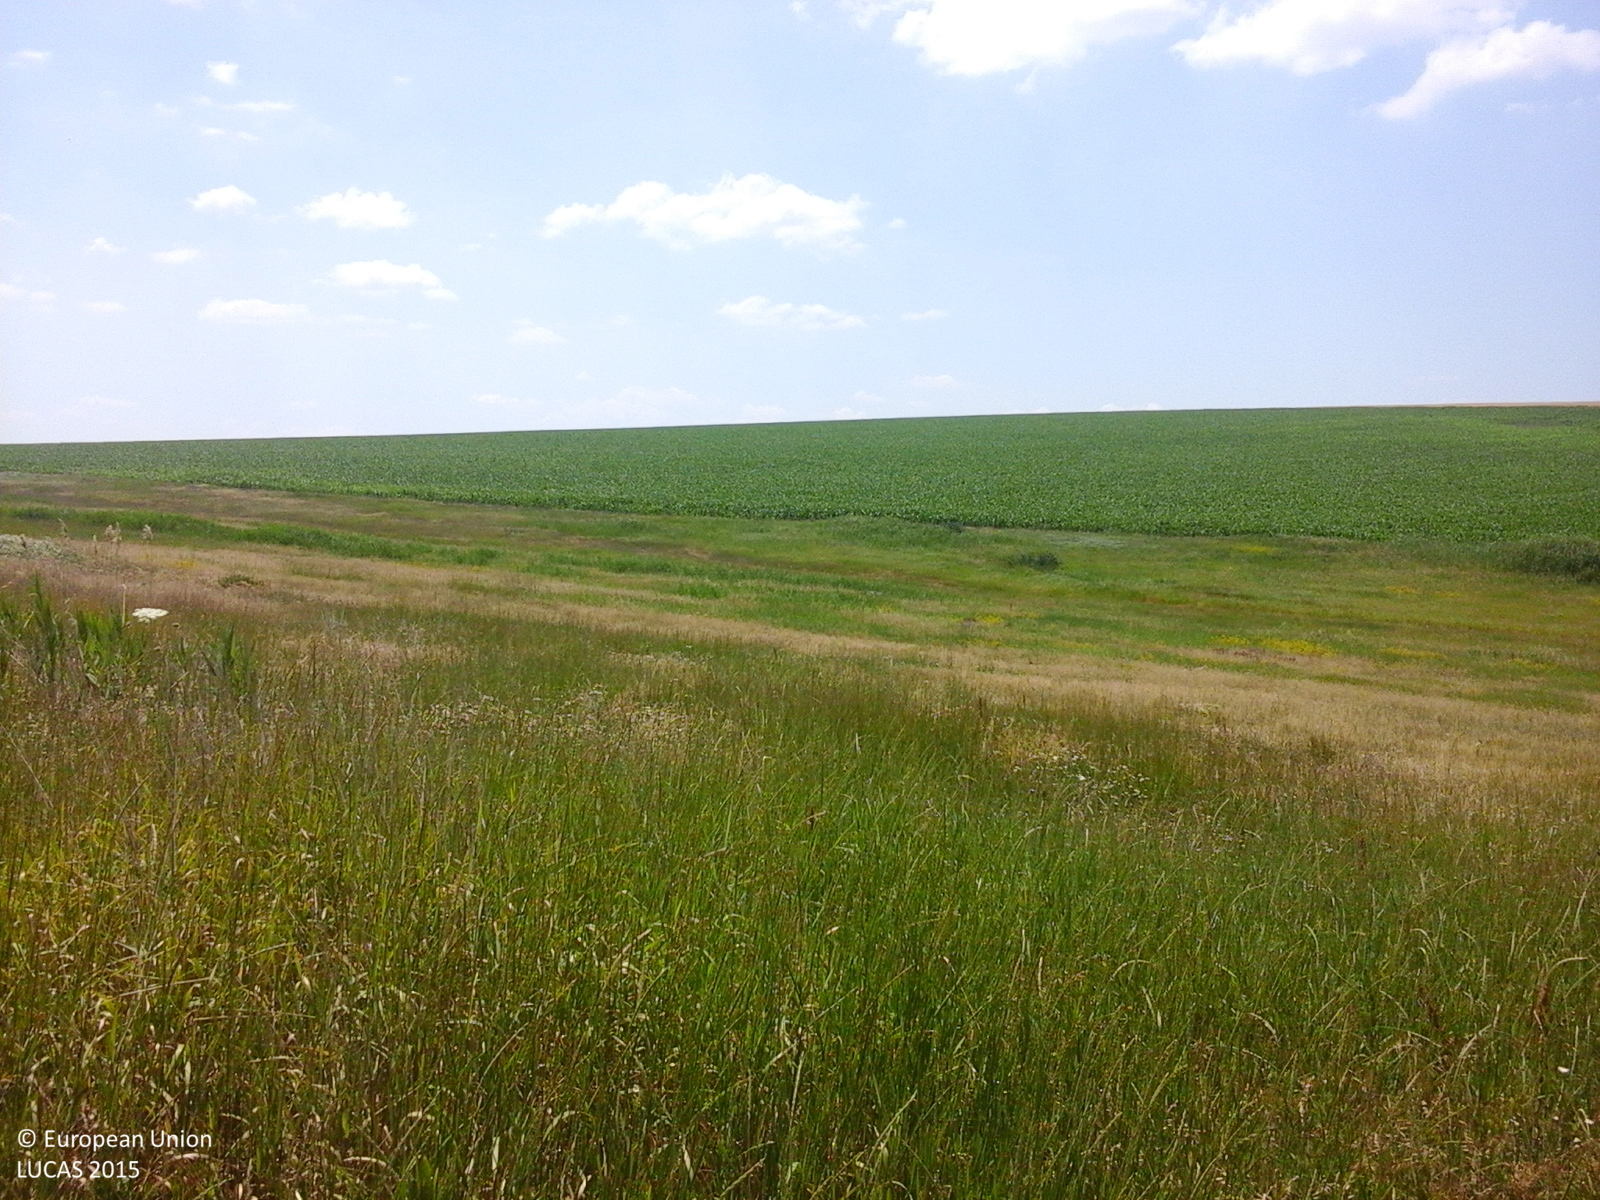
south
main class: Grassland
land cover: Grassland without tree/shrub cover
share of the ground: > 75 %
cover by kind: herbaceous plants 100 %
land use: Agriculture (excluding fallow land and kitchen gardens)
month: June
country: RO
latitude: 47.2383
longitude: 27.3507
